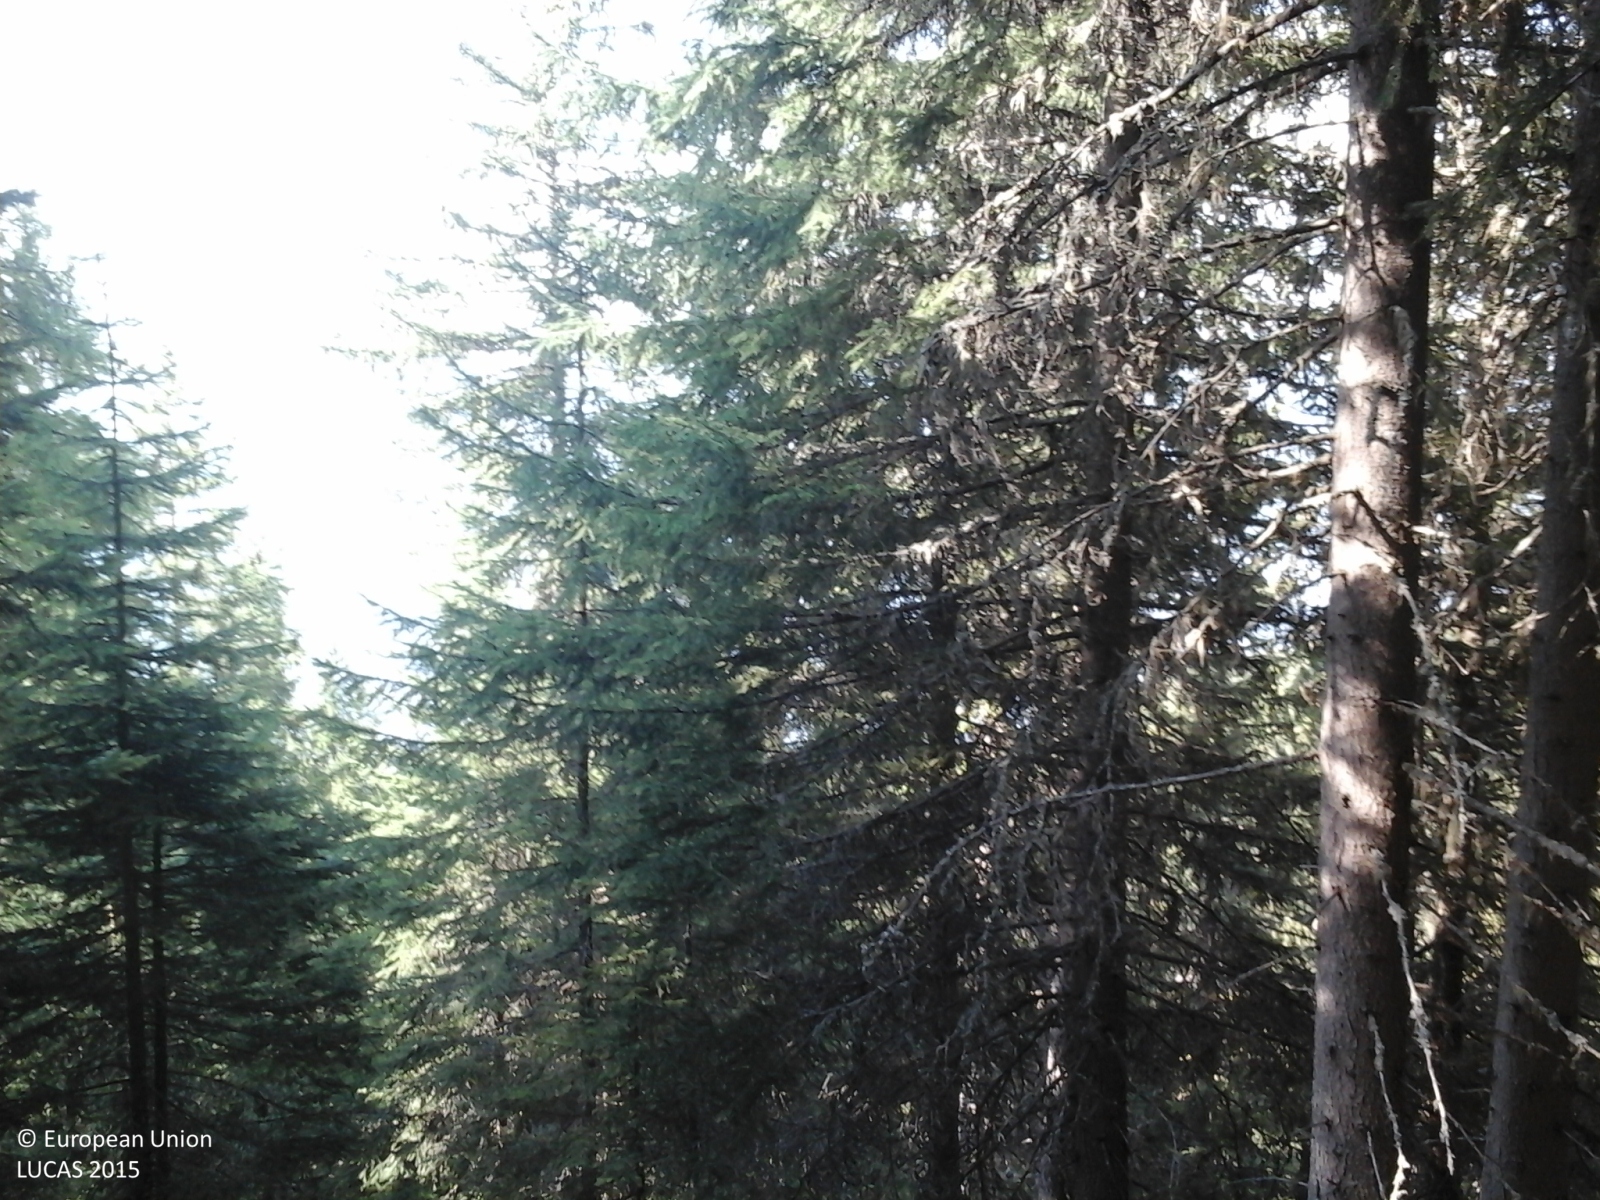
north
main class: Woodland
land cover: Other coniferous woodland
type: alpine coniferous forest
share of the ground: > 75 %
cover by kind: coniferous forest trees 100 %
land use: Forestry
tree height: > 5 m
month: August
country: IT
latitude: 45.6855
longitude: 7.2689
